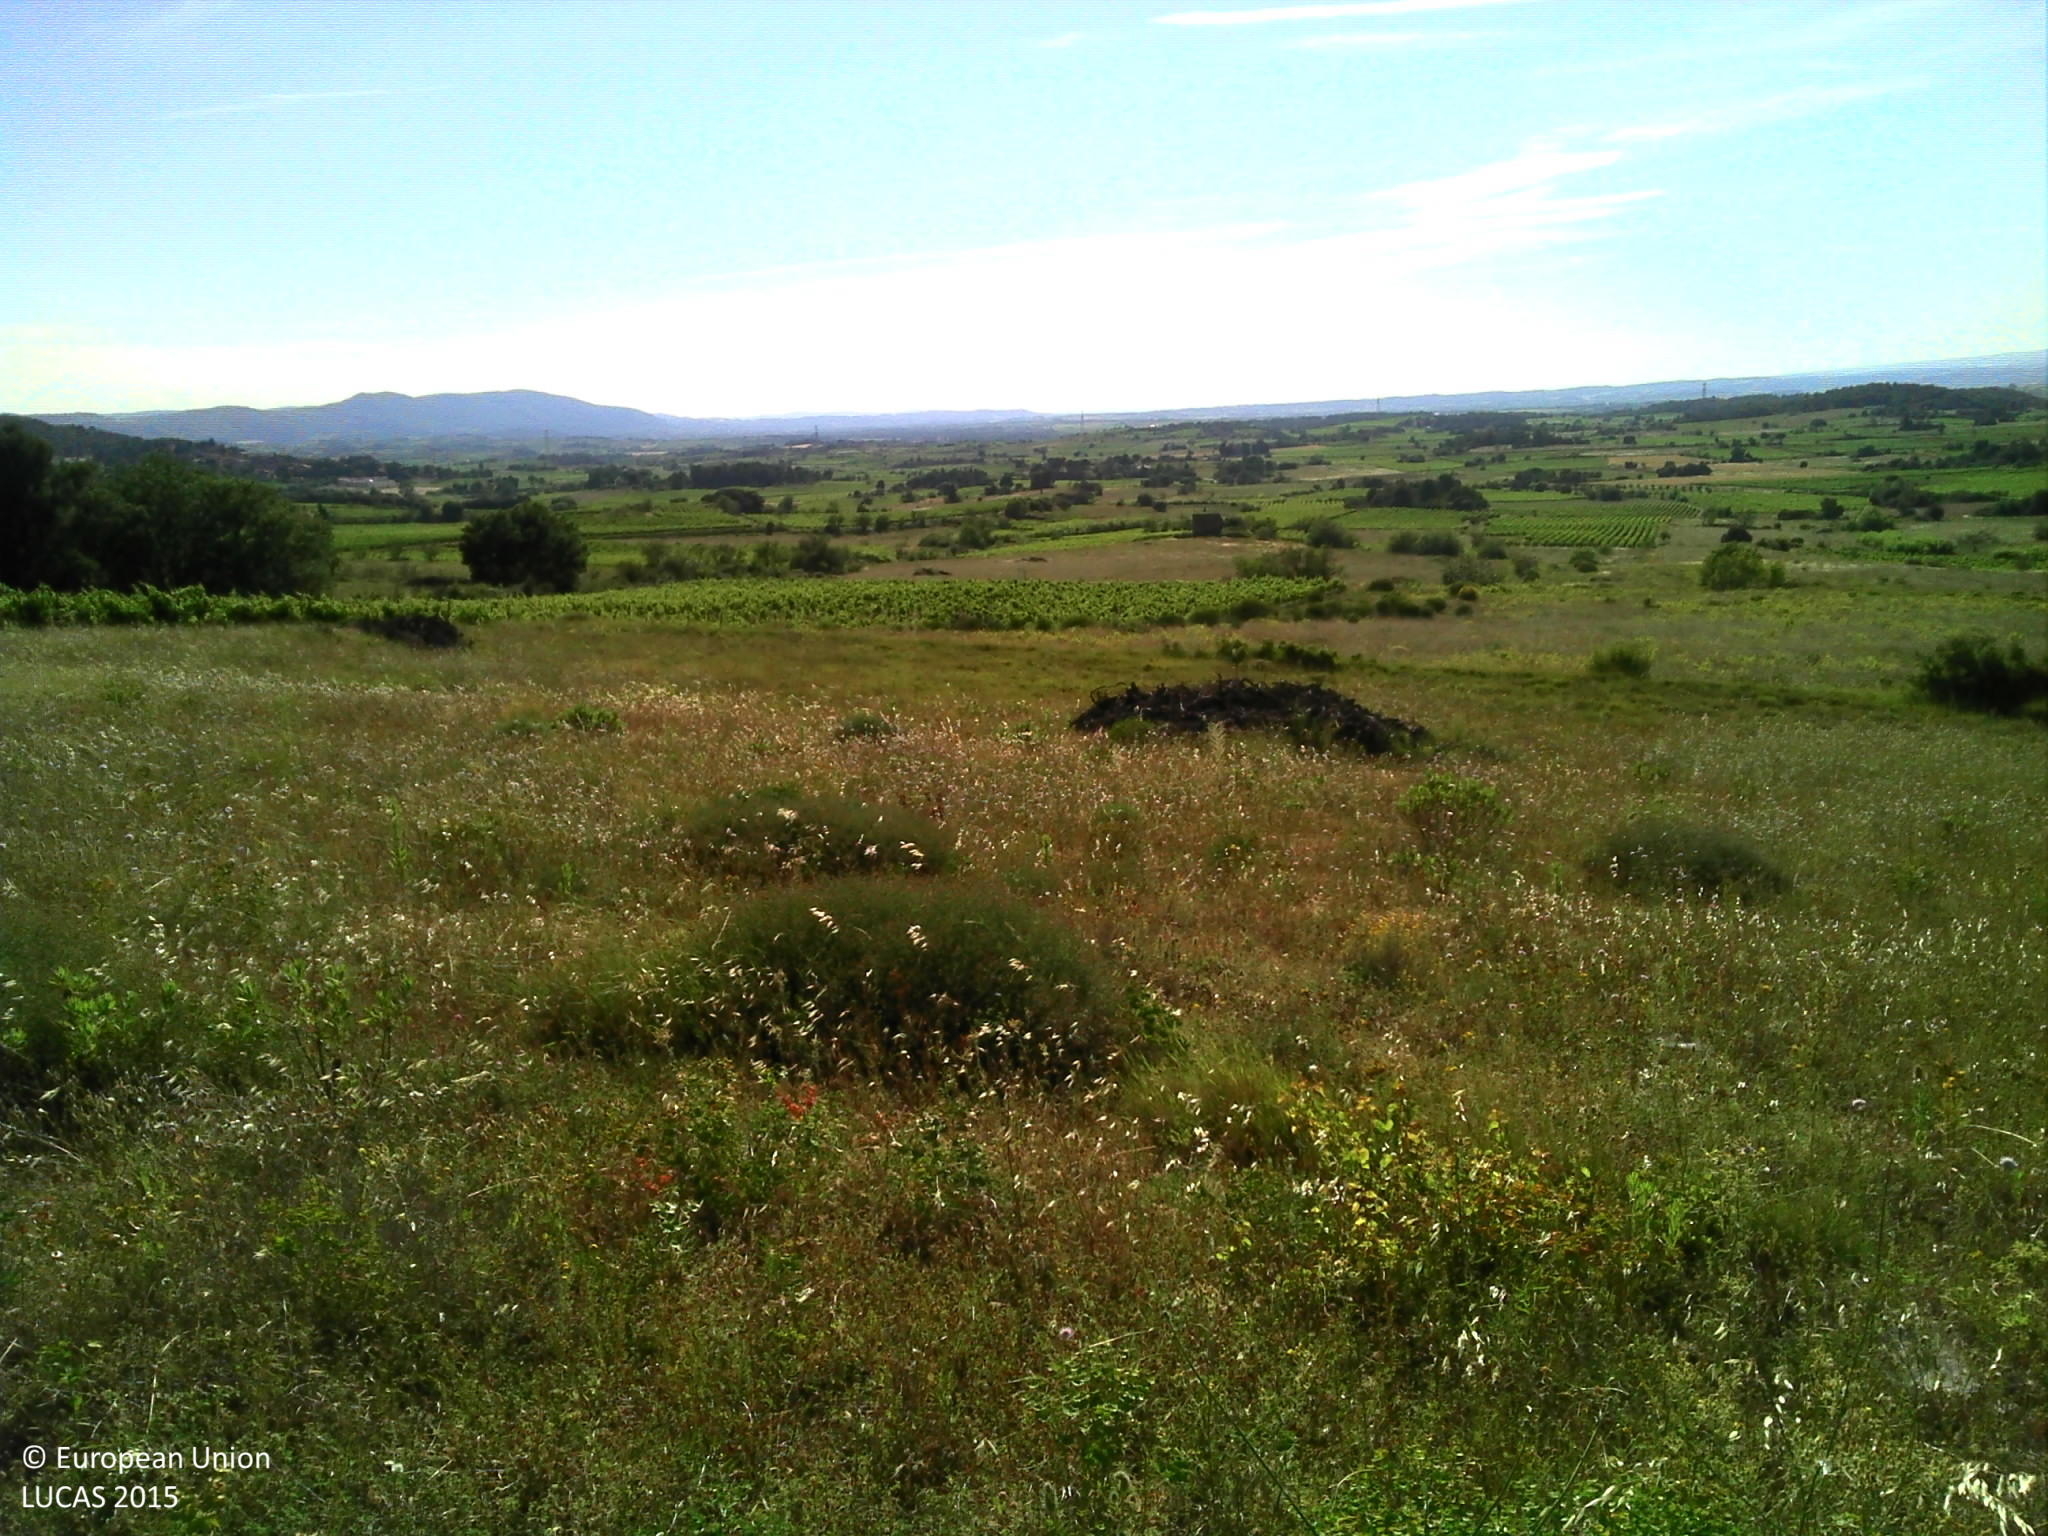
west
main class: Grassland
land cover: Spontaneously vegetated surfaces
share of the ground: > 75 %
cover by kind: herbaceous plants 95 %, shrubs 5 %
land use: Semi-natural and natural areas not in use
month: June
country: FR
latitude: 43.2066
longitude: 2.7104
